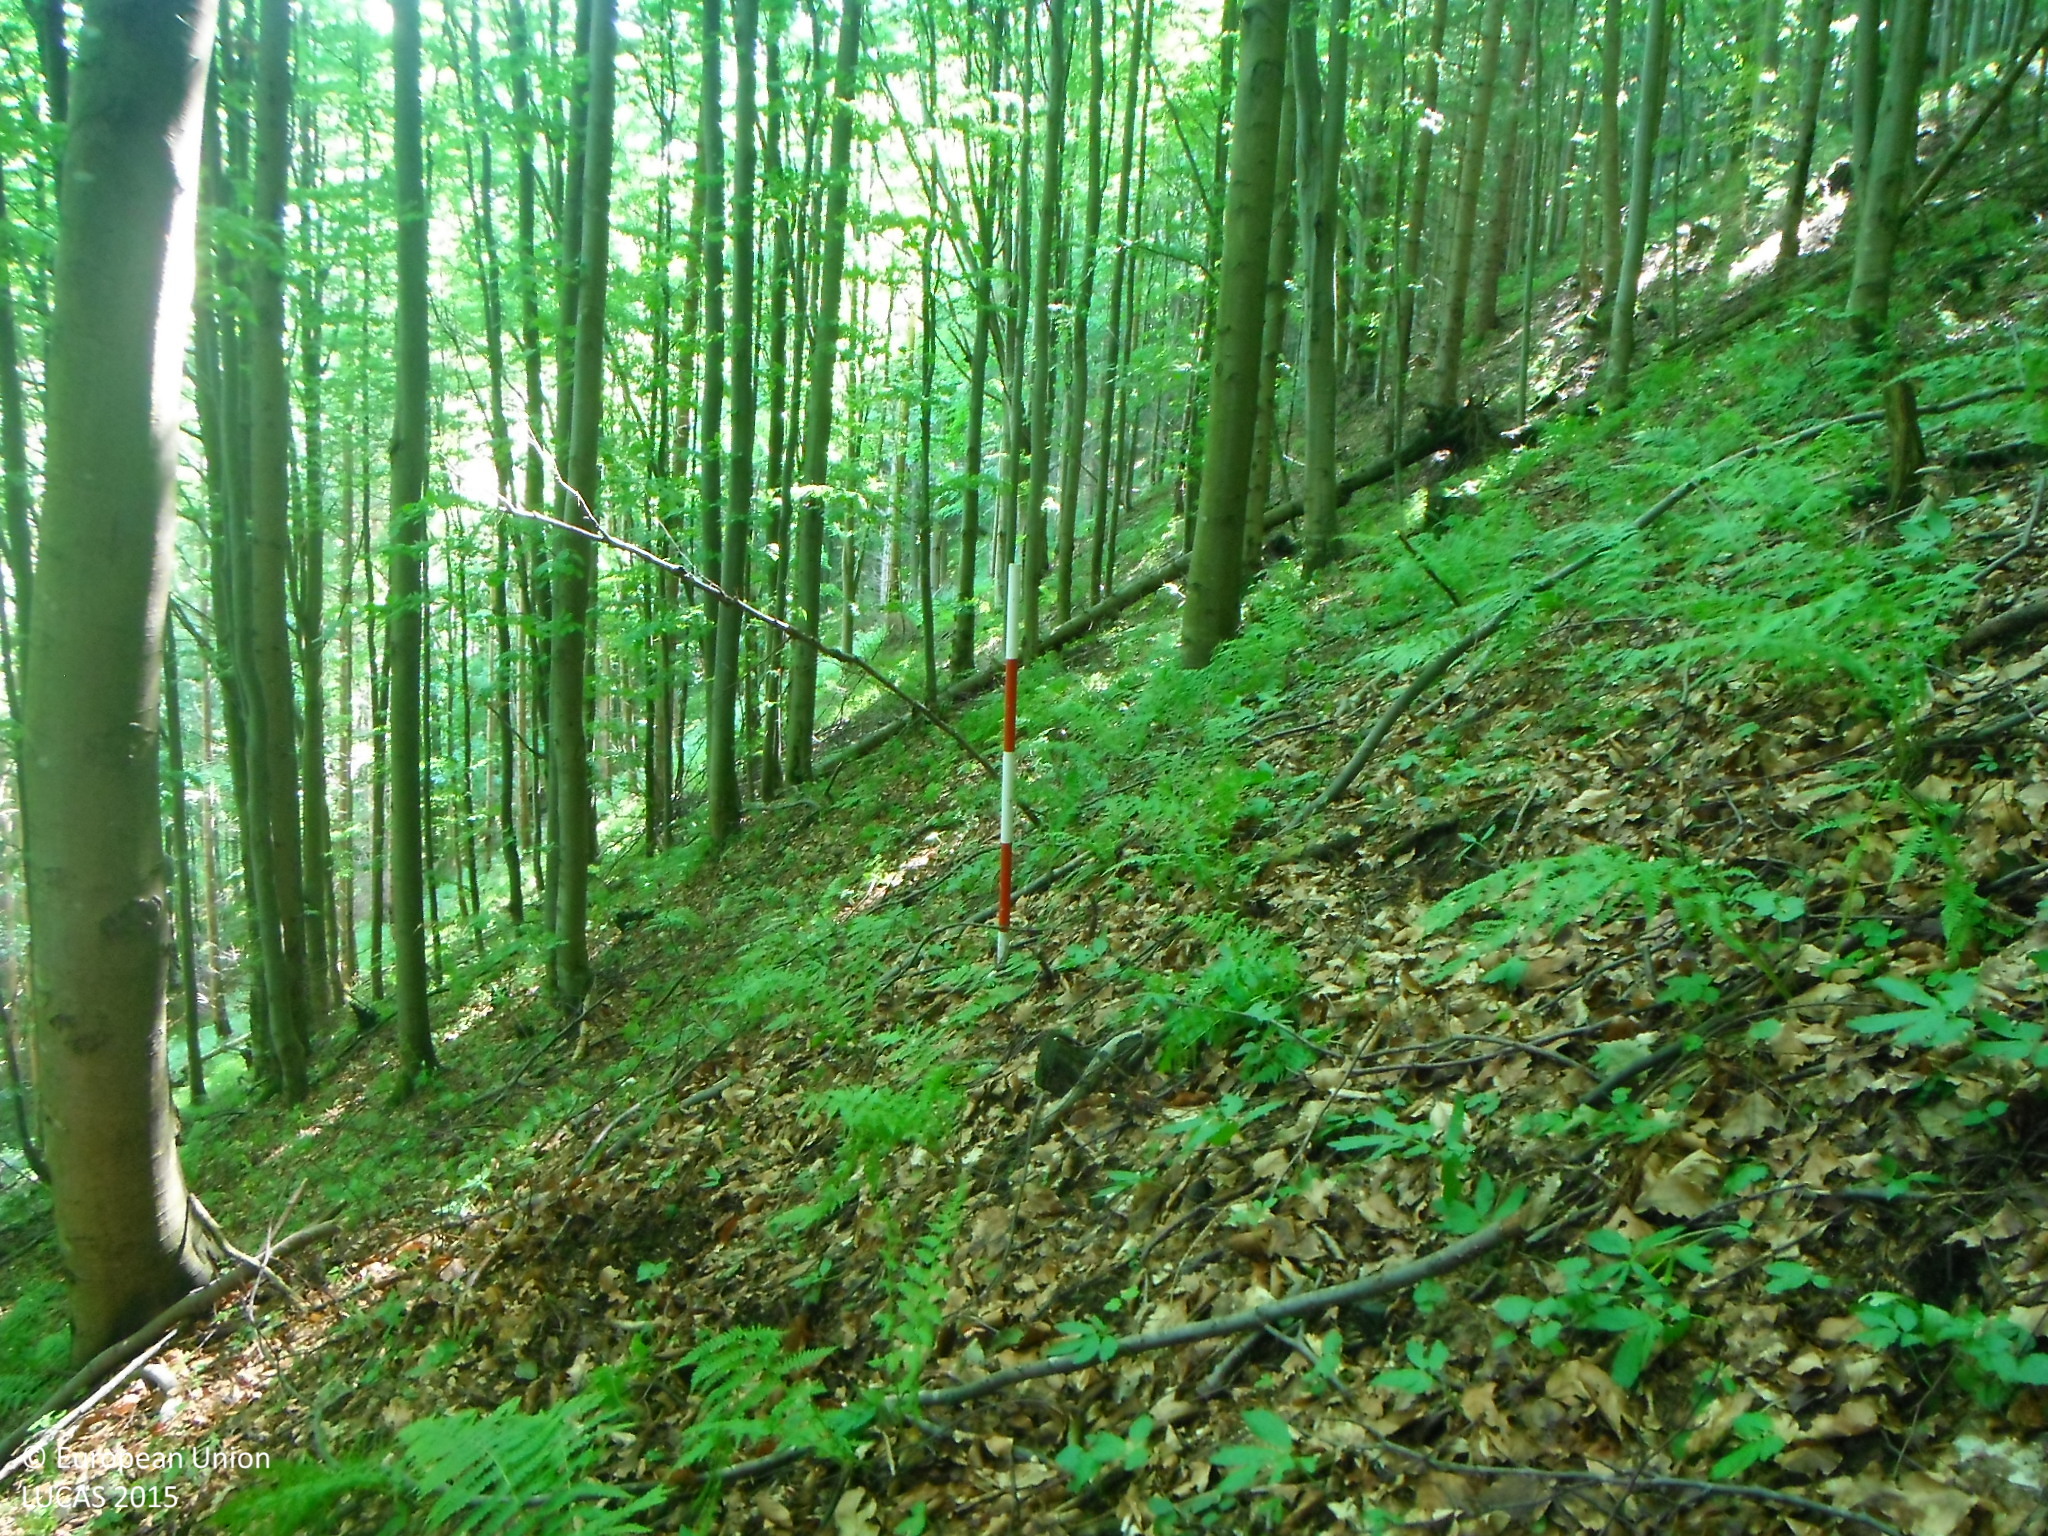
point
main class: Woodland
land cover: Broadleaved woodland
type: hemiboreal forest and nemoral coniferous forest and mixed broadleaved-coniferous forest
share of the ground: > 75 %
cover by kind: broadleaved forest trees 95 %, coniferous forest trees 5 %
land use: Forestry
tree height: > 5 m
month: June
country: SK
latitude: 48.7613
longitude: 19.8370
